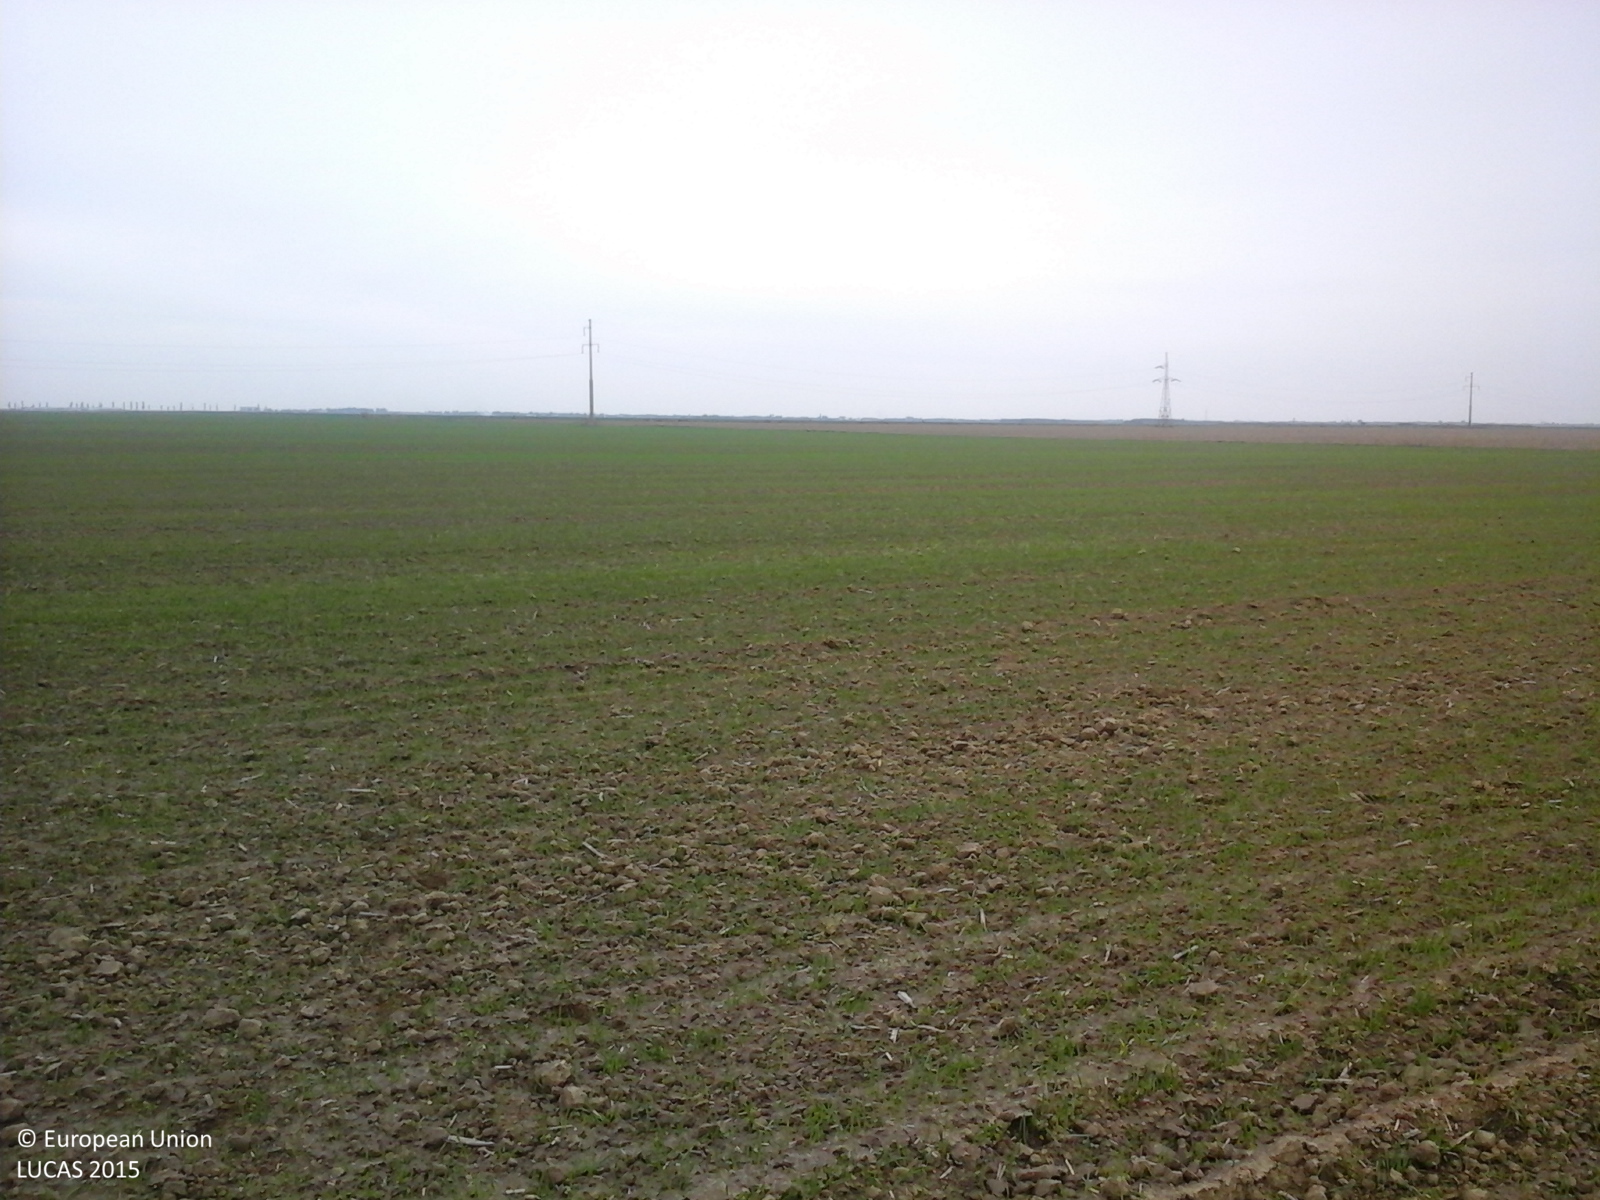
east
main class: Cropland
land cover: Common wheat
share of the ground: 25 - 50 %
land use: Agriculture (excluding fallow land and kitchen gardens)
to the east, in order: Common wheat; Tracks; Grass margins; Other bare soil
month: October
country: RO
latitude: 44.8264
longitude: 26.3420
